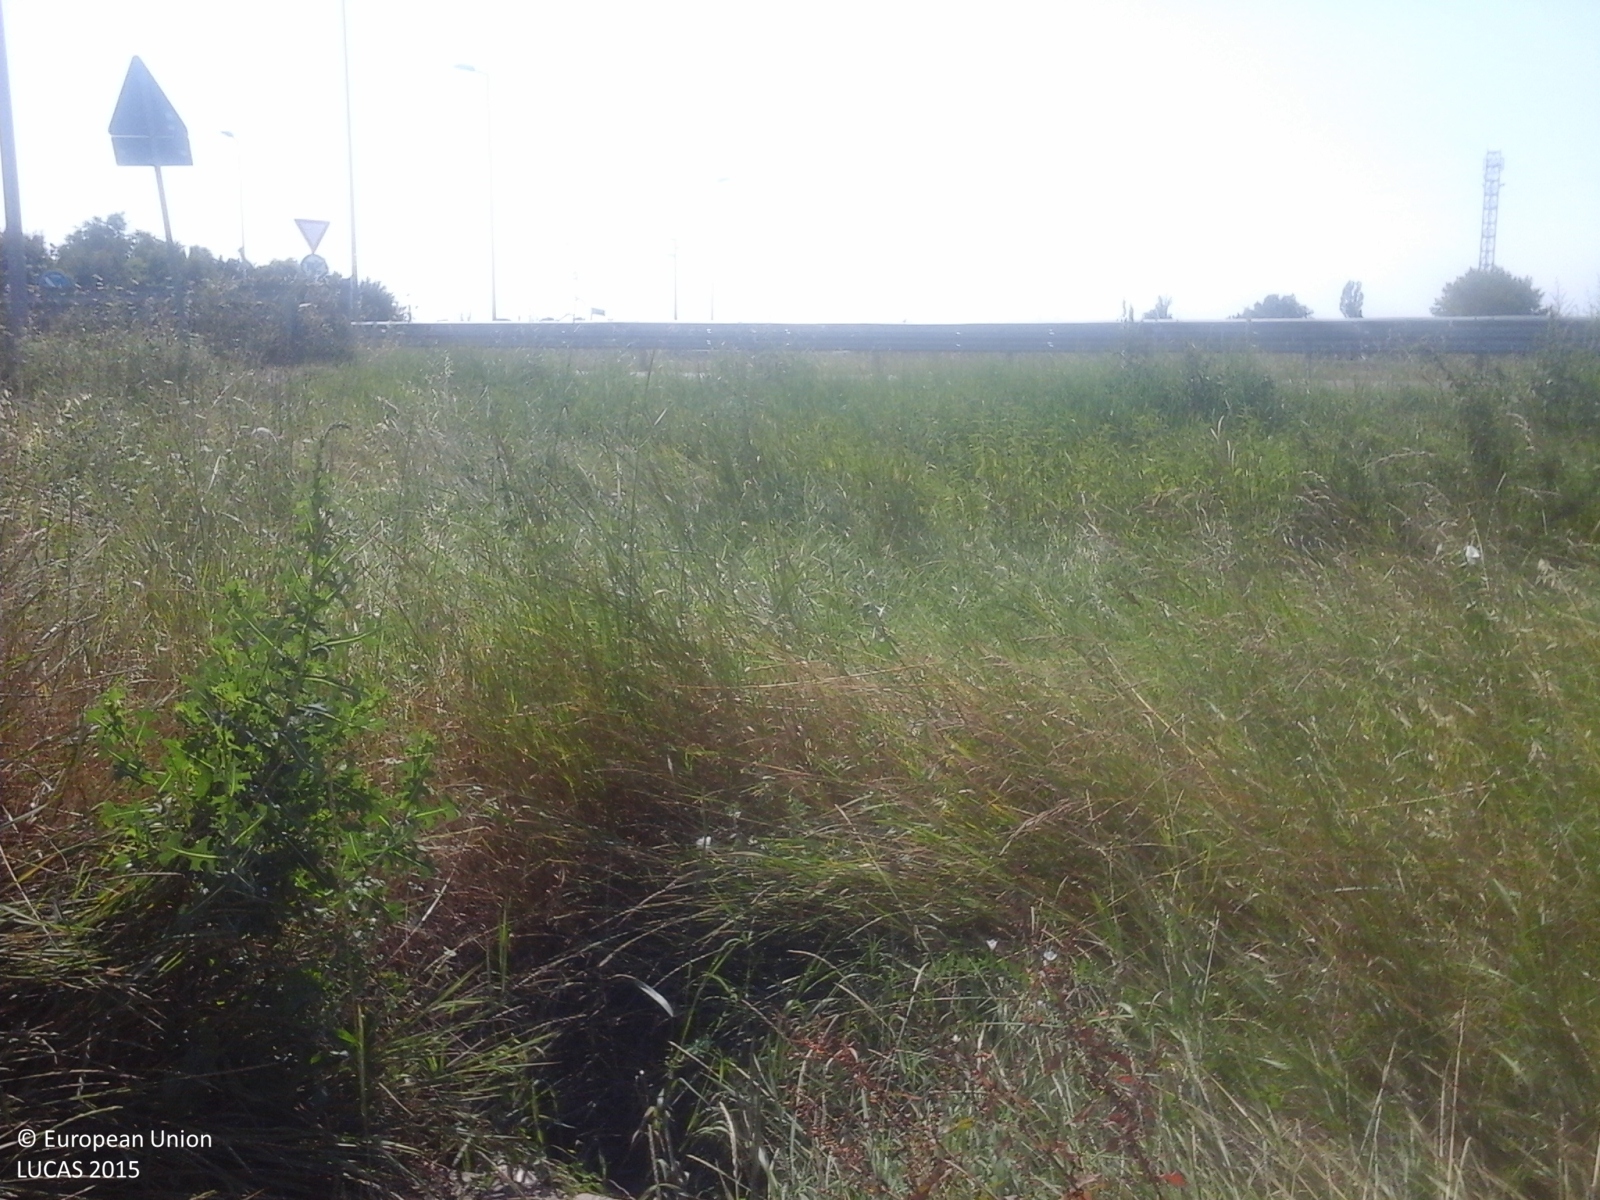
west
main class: Cropland
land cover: Common wheat
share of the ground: > 75 %
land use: Agriculture (excluding fallow land and kitchen gardens)
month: June
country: IT
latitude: 44.6880
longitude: 11.0451
